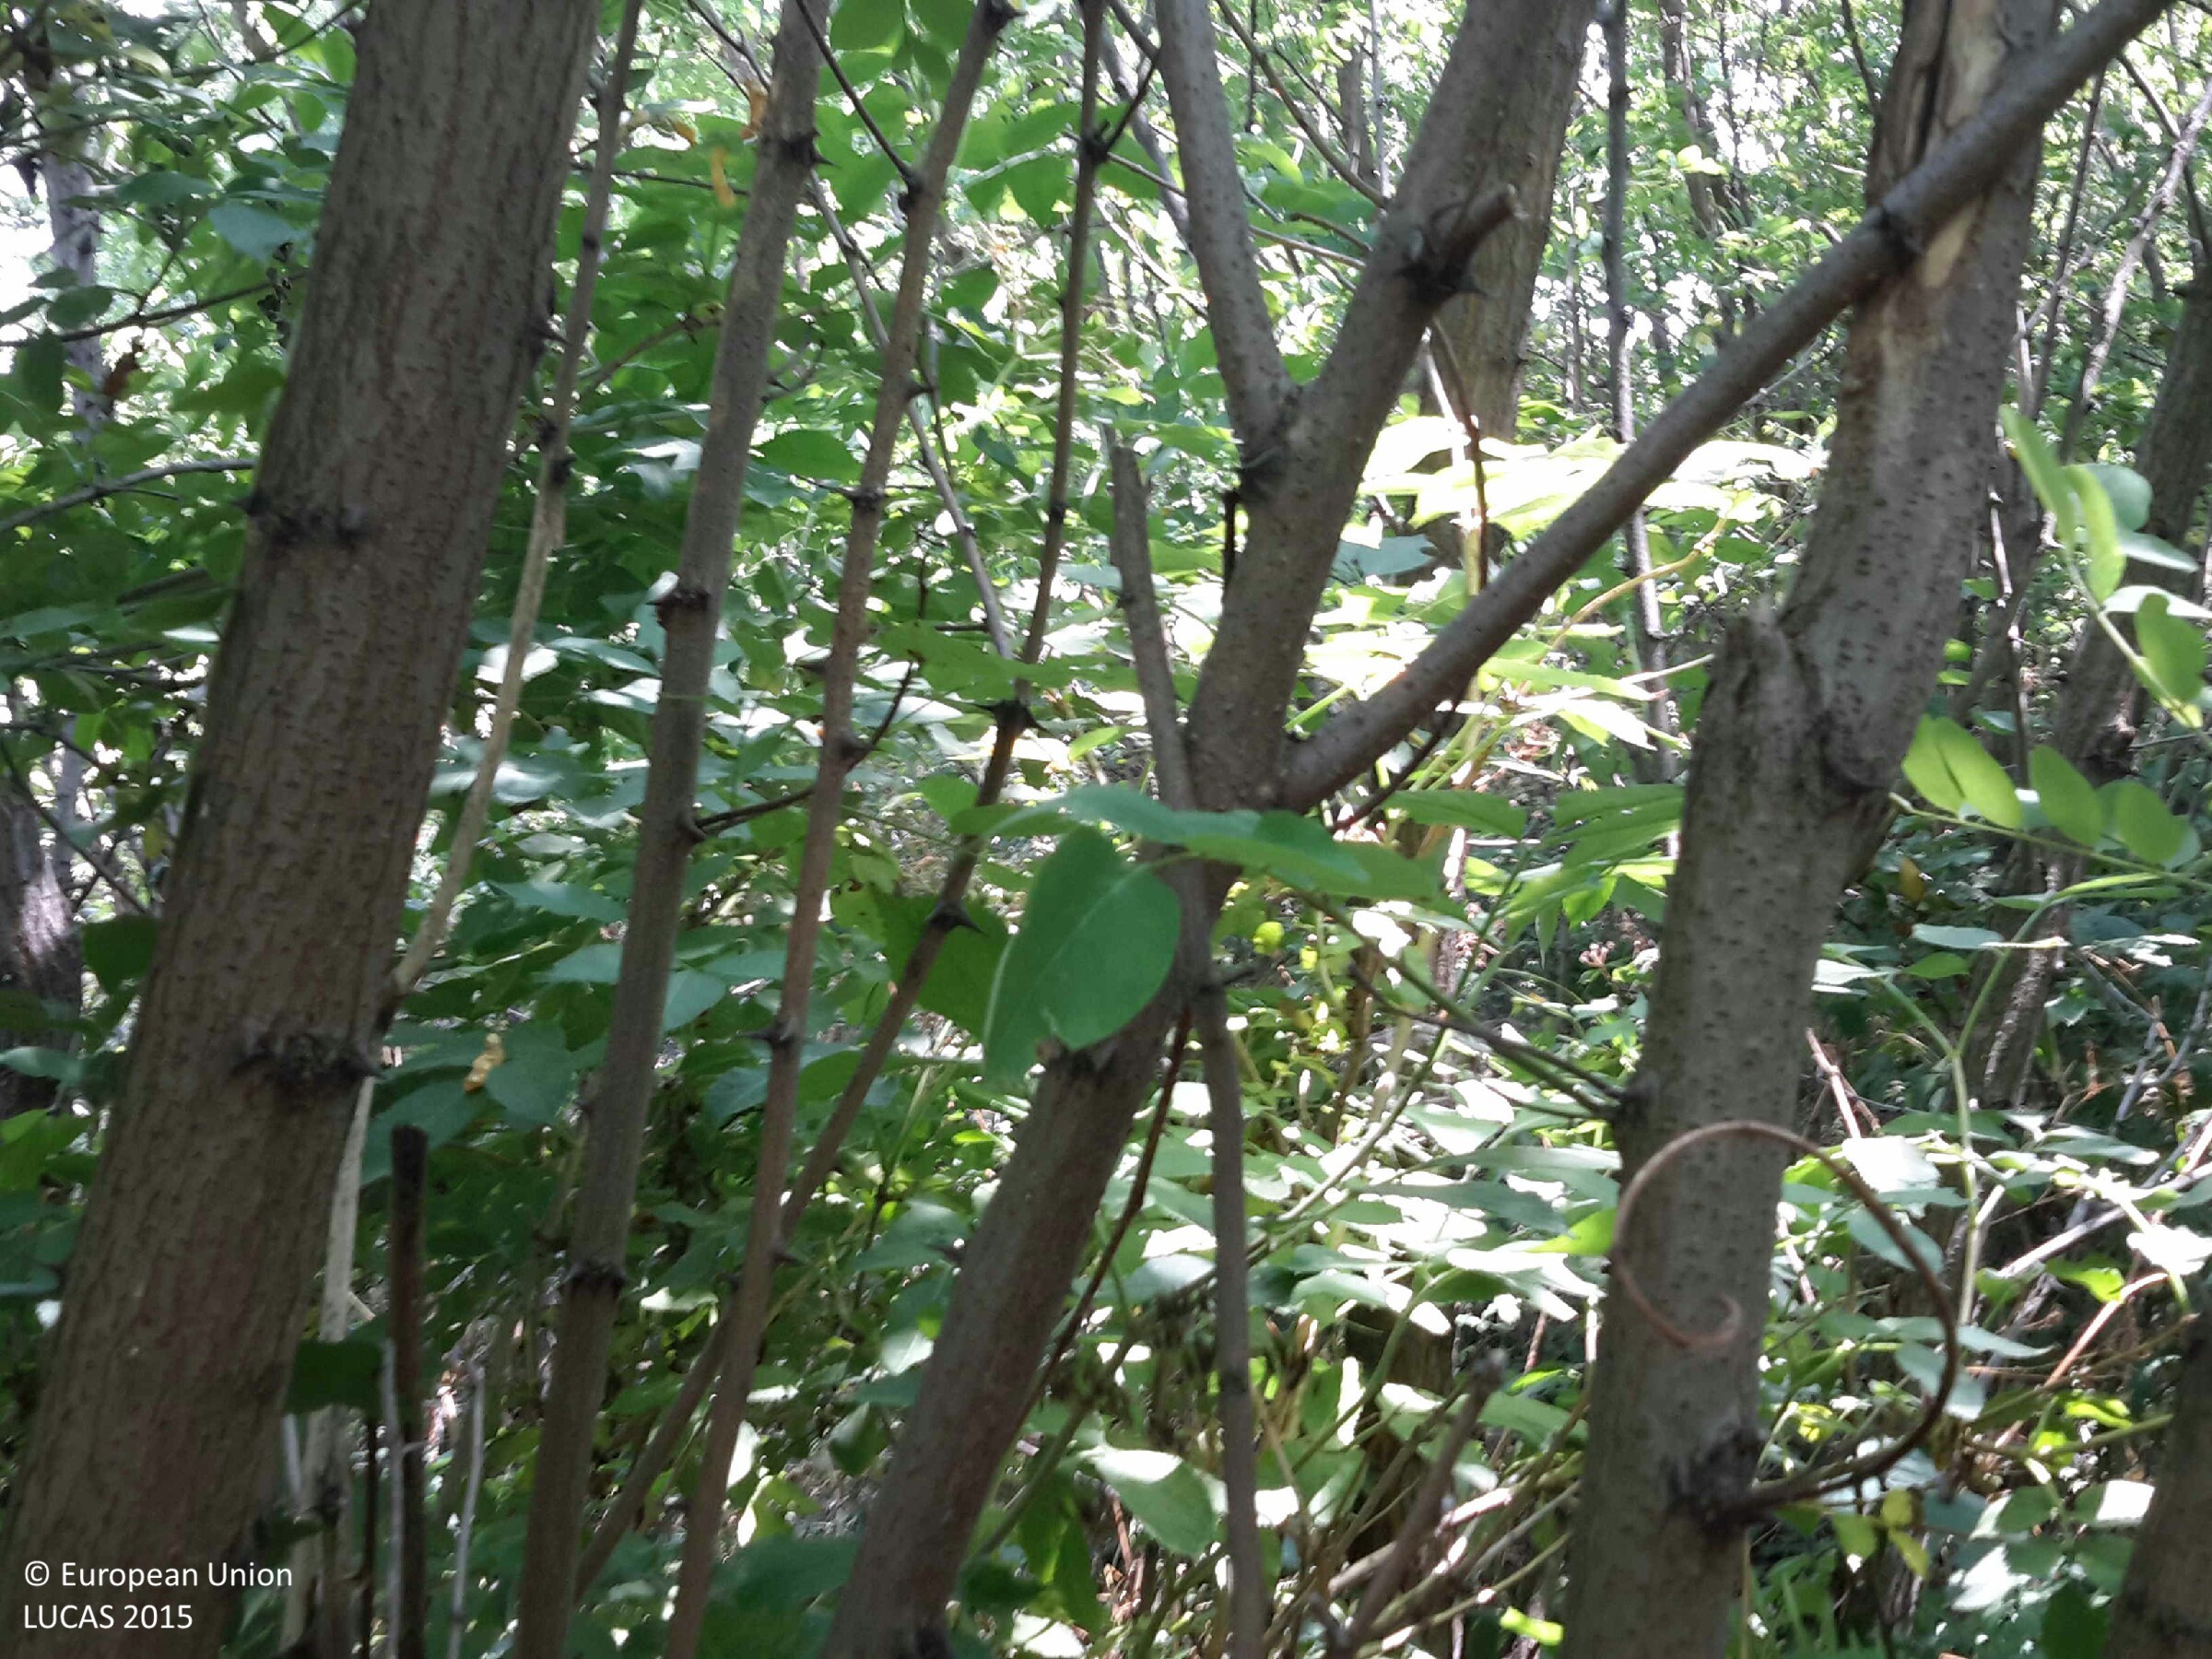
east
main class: Woodland
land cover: Broadleaved woodland
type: thermophilous deciduous forest
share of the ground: > 75 %
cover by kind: broadleaved forest trees 90 %, herbaceous plants 10 %
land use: Forestry
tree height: > 5 m
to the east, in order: Broadleaved woodland; Grassland without tree/shrub cover; Shrubland with sparse tree cover; Electric lines; Paved roads, cycling and walking lanes; Grassland without tree/shrub cover; Vineyards; Spontaneously vegetated surfaces
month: July
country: HU
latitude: 47.6225
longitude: 16.6978
